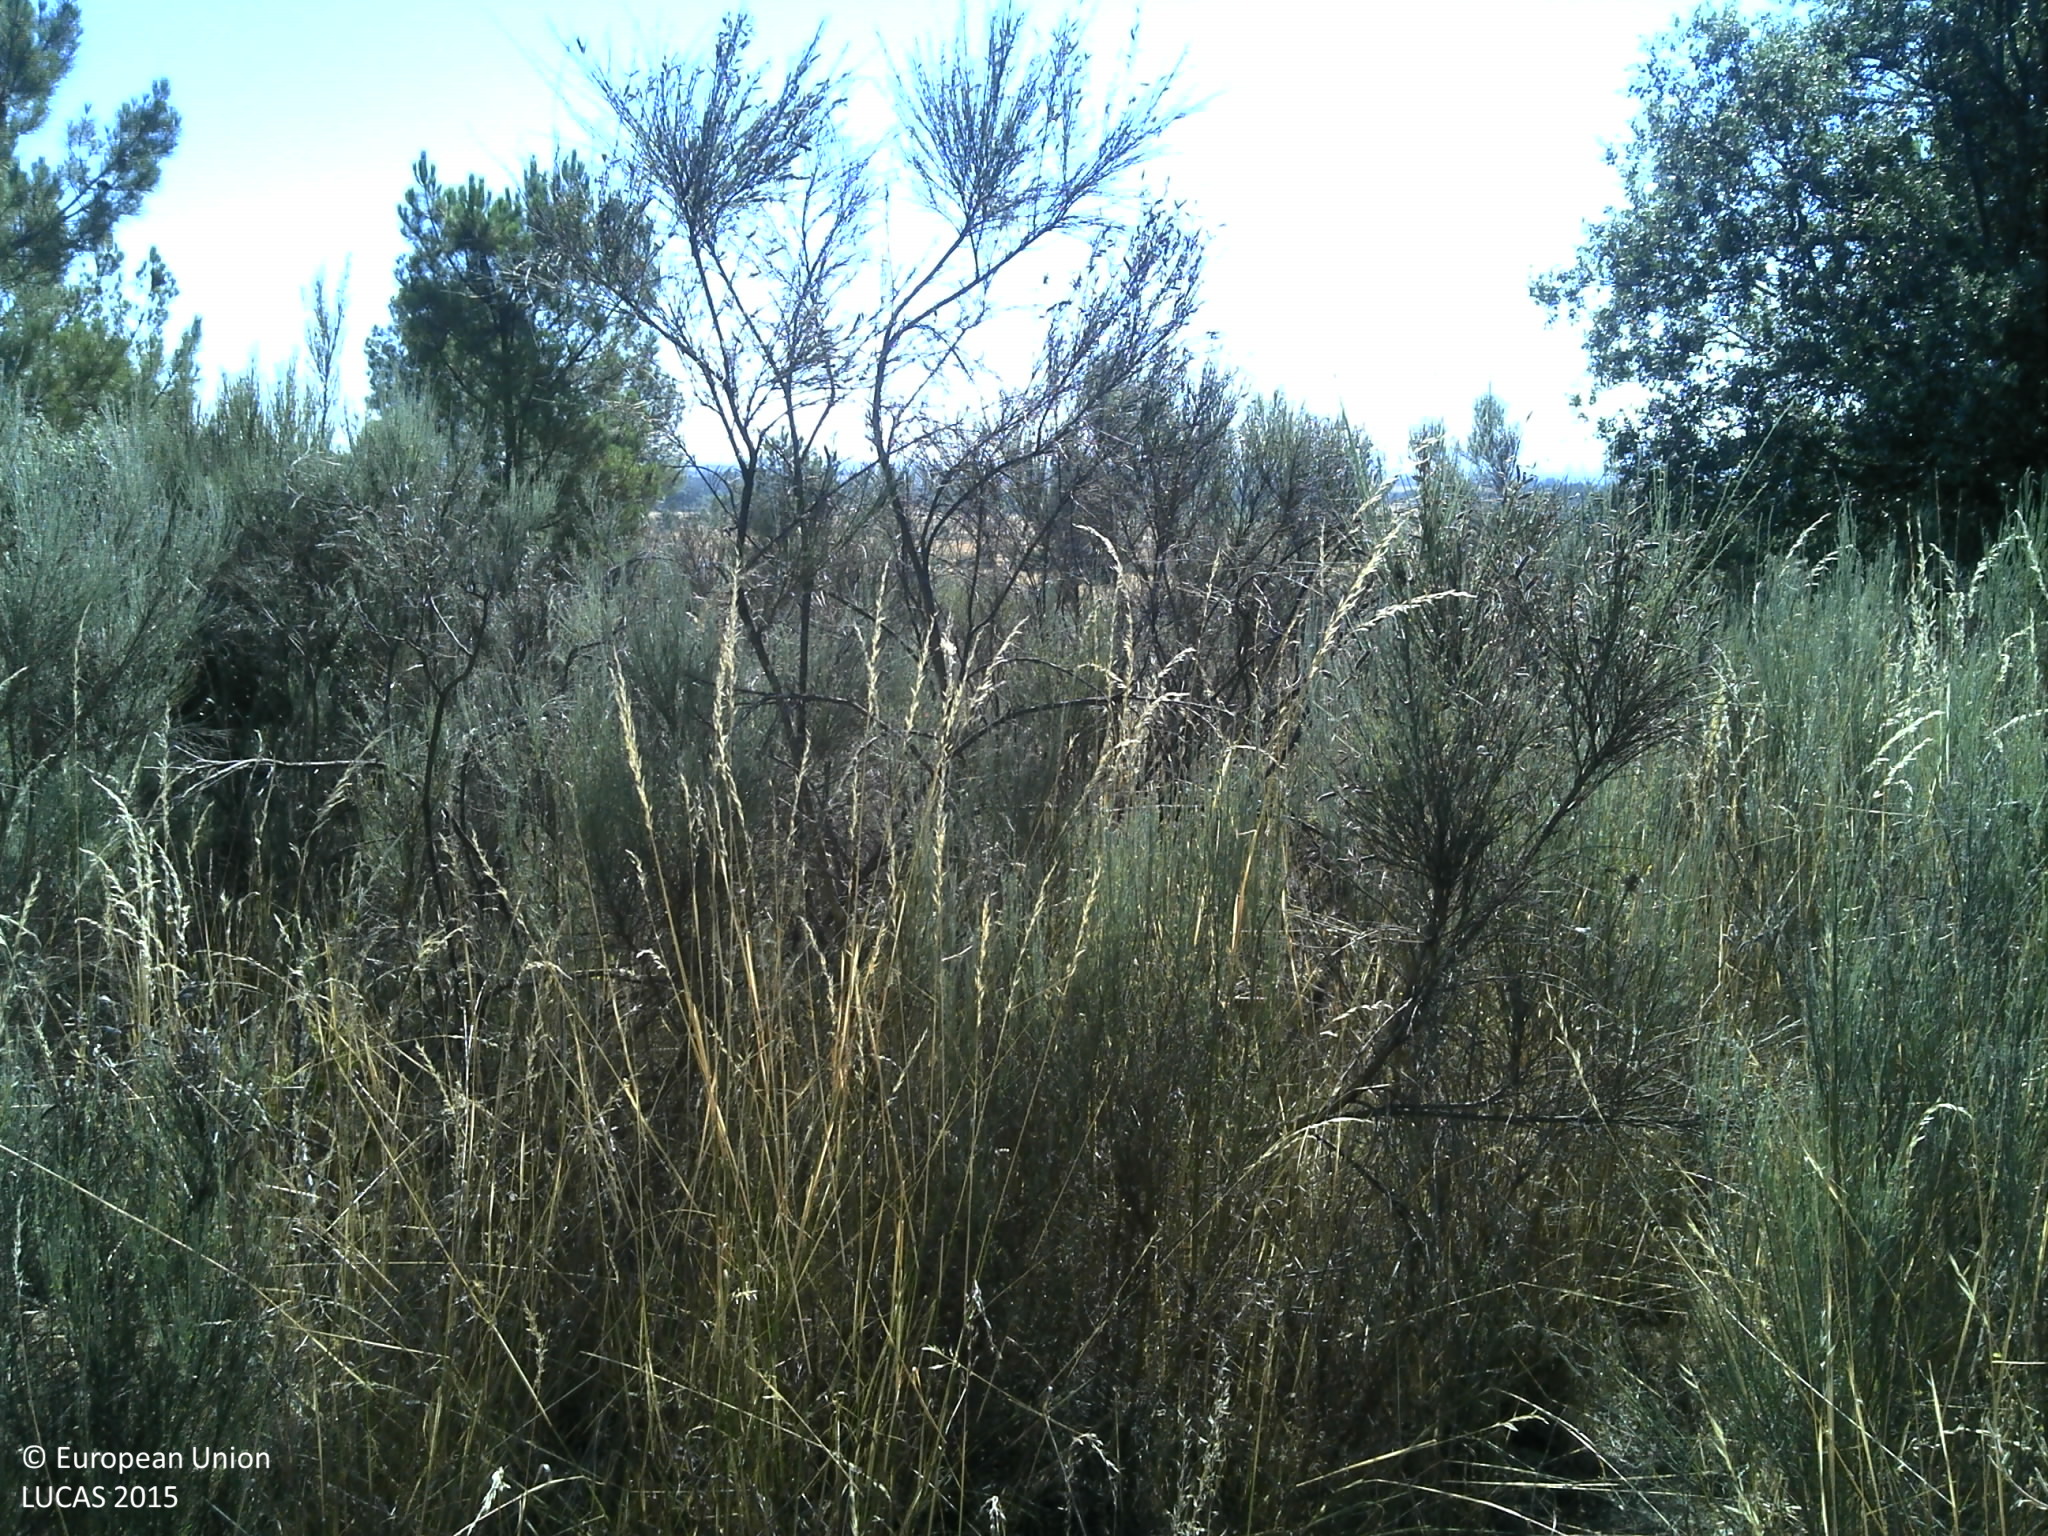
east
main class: Shrubland
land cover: Shrubland with sparse tree cover
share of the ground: 50 - 75 %
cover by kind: shrubs 60 %, herbaceous plants 15 %, consolidated bare surface 10 %, unconsolidated bare surface 10 %, broadleaved forest trees 5 %
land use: Semi-natural and natural areas not in use
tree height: > 5 m
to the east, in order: Shrubland with sparse tree cover; Tracks; Shrubland with sparse tree cover; Pine dominated mixed woodland; Shrubland without tree cover; Grassland without tree/shrub cover; Ditches and canals
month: June
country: PT
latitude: 40.8908
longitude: -7.2134
